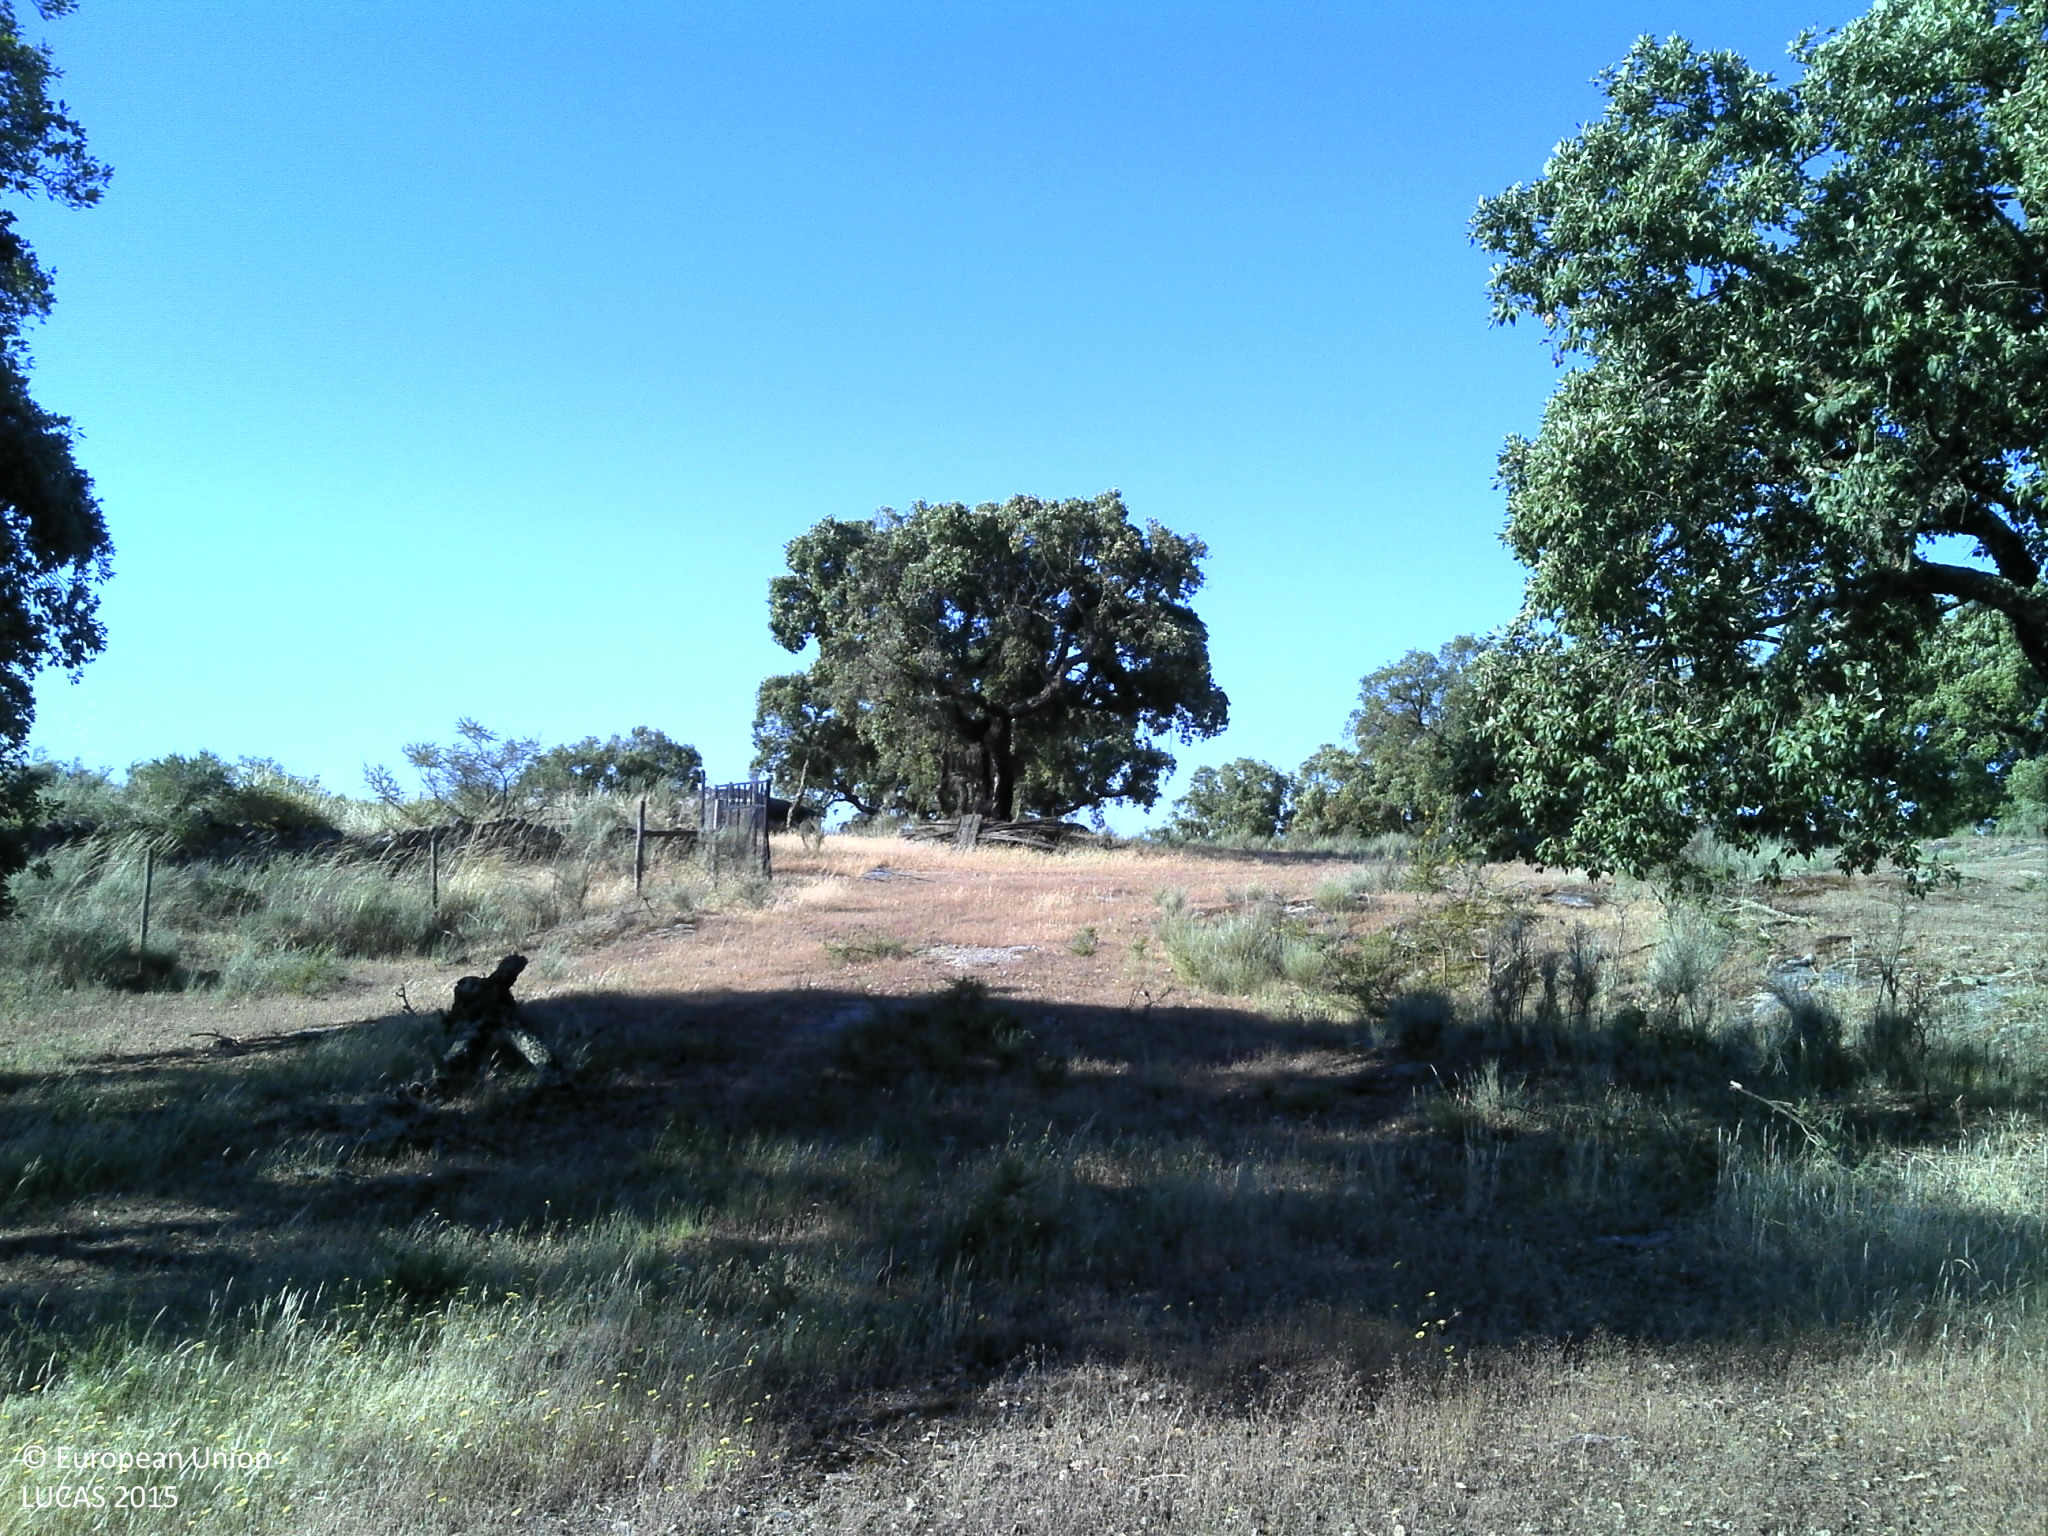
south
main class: Woodland
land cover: Broadleaved woodland
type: broadleaved evergreen forest
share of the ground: 10 - 25 %
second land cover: Grassland without tree/shrub cover
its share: 25 - 50 %
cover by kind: herbaceous plants 50 %, unconsolidated bare surface 30 %, broadleaved forest trees 20 %
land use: Forestry
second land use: Agriculture (excluding fallow land and kitchen gardens)
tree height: > 5 m
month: May
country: PT
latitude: 39.4194
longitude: -7.5988
